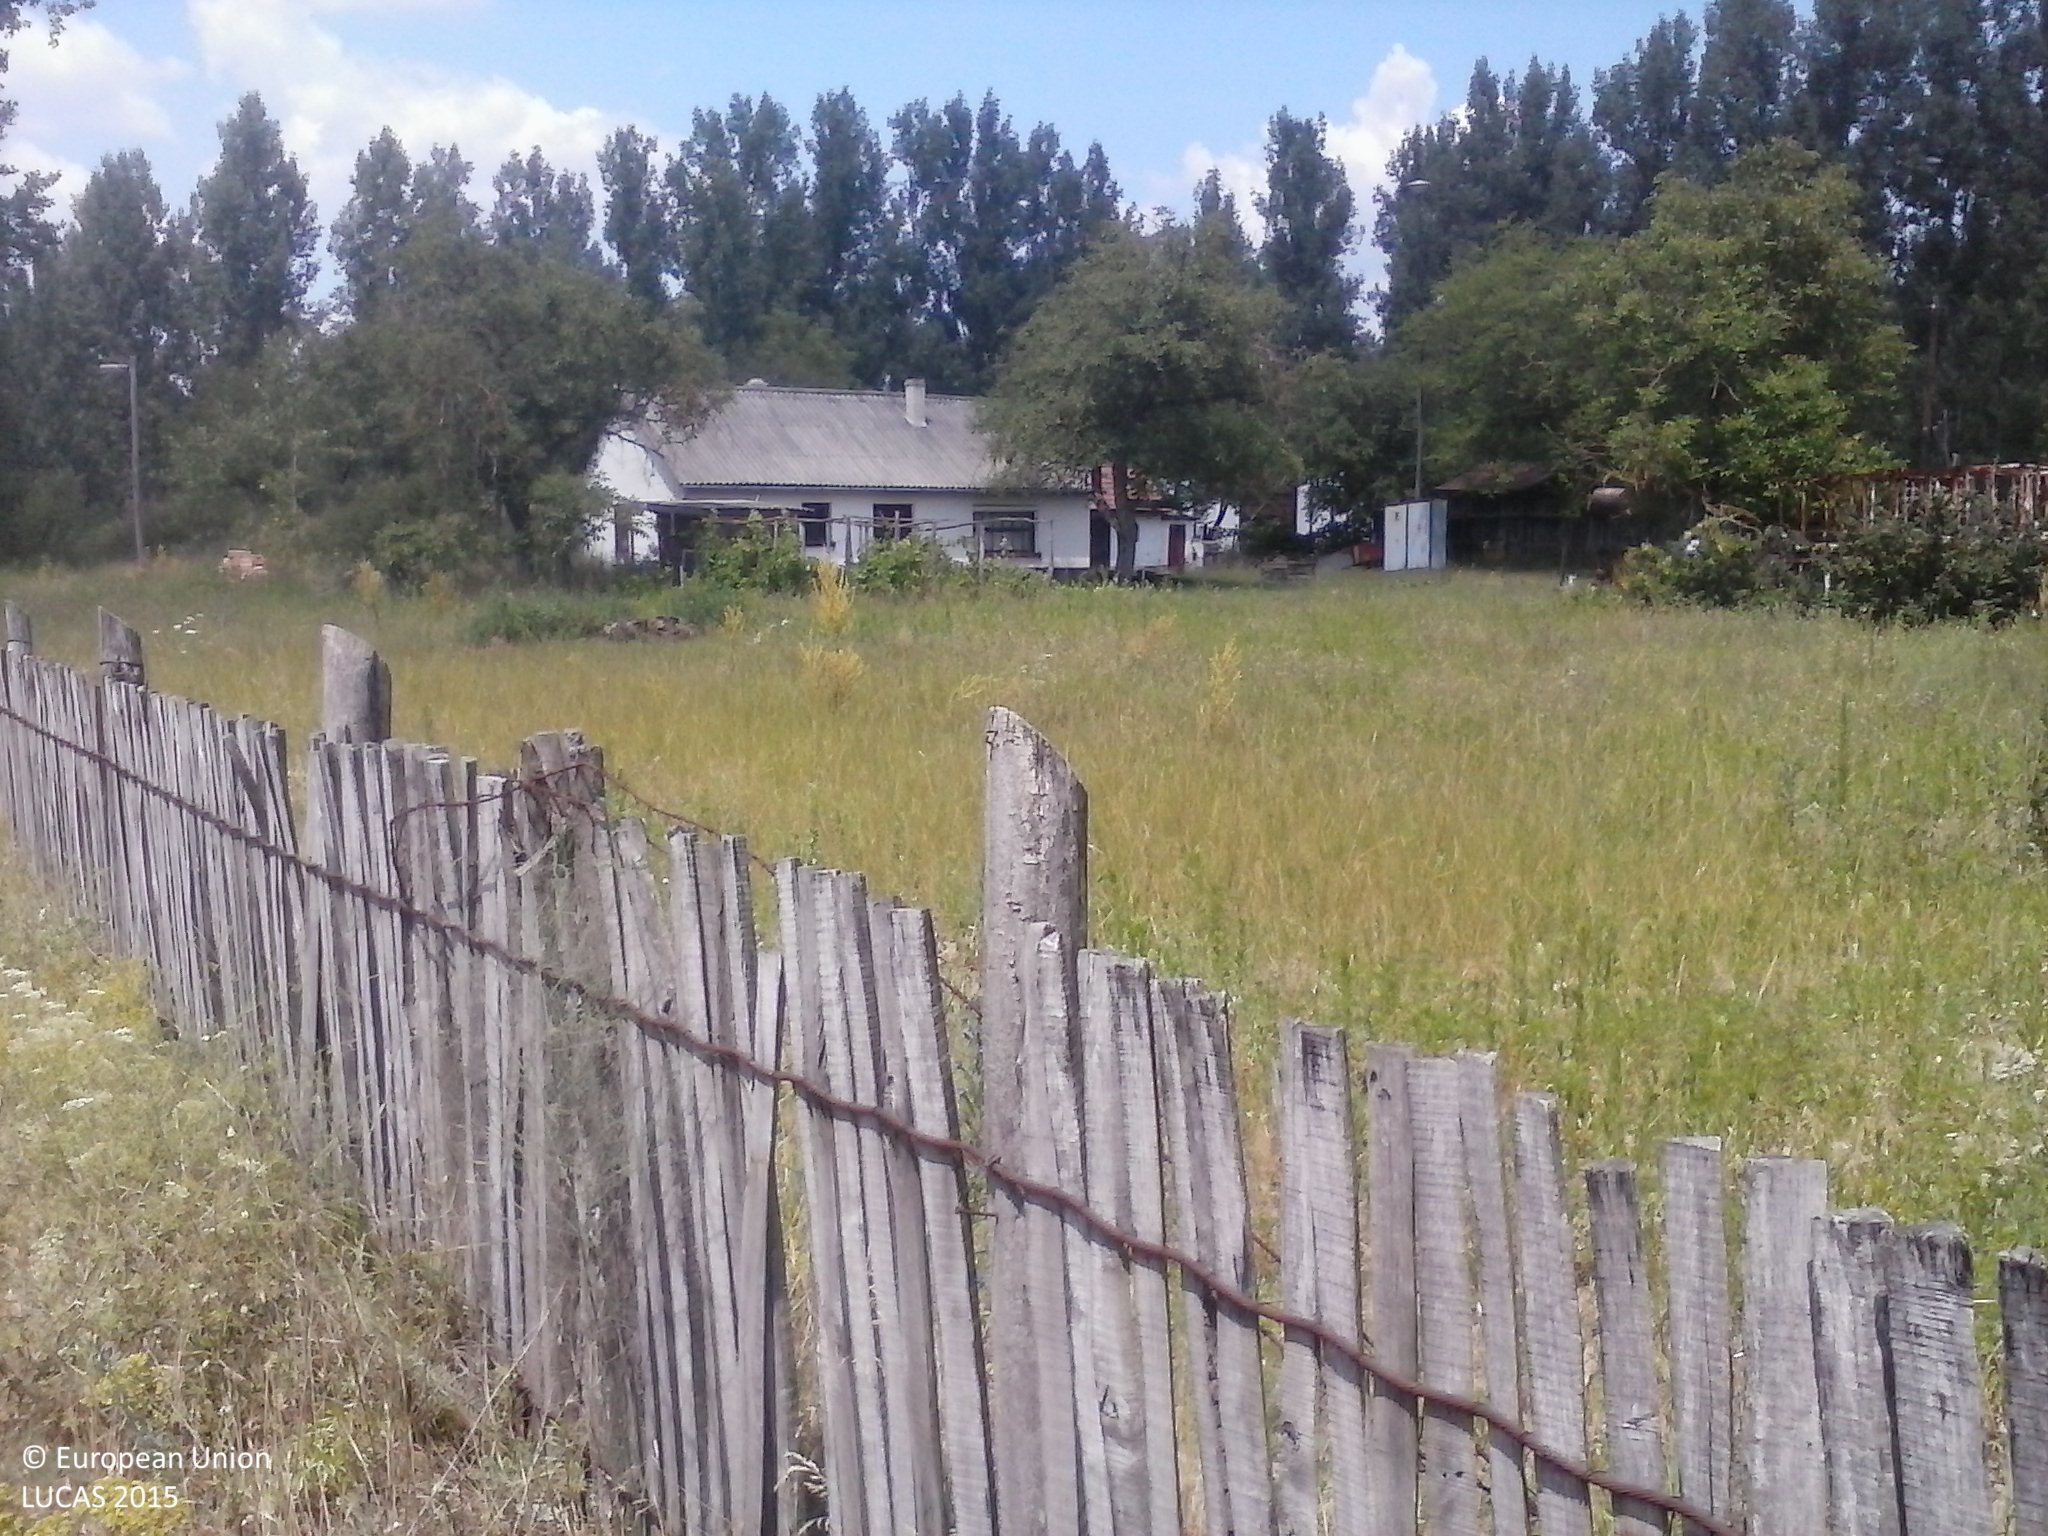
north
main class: Grassland
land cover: Grassland without tree/shrub cover
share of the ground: > 75 %
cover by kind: herbaceous plants 100 %
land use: Agriculture (excluding fallow land and kitchen gardens)
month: July
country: HU
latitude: 46.3587
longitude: 19.5437
